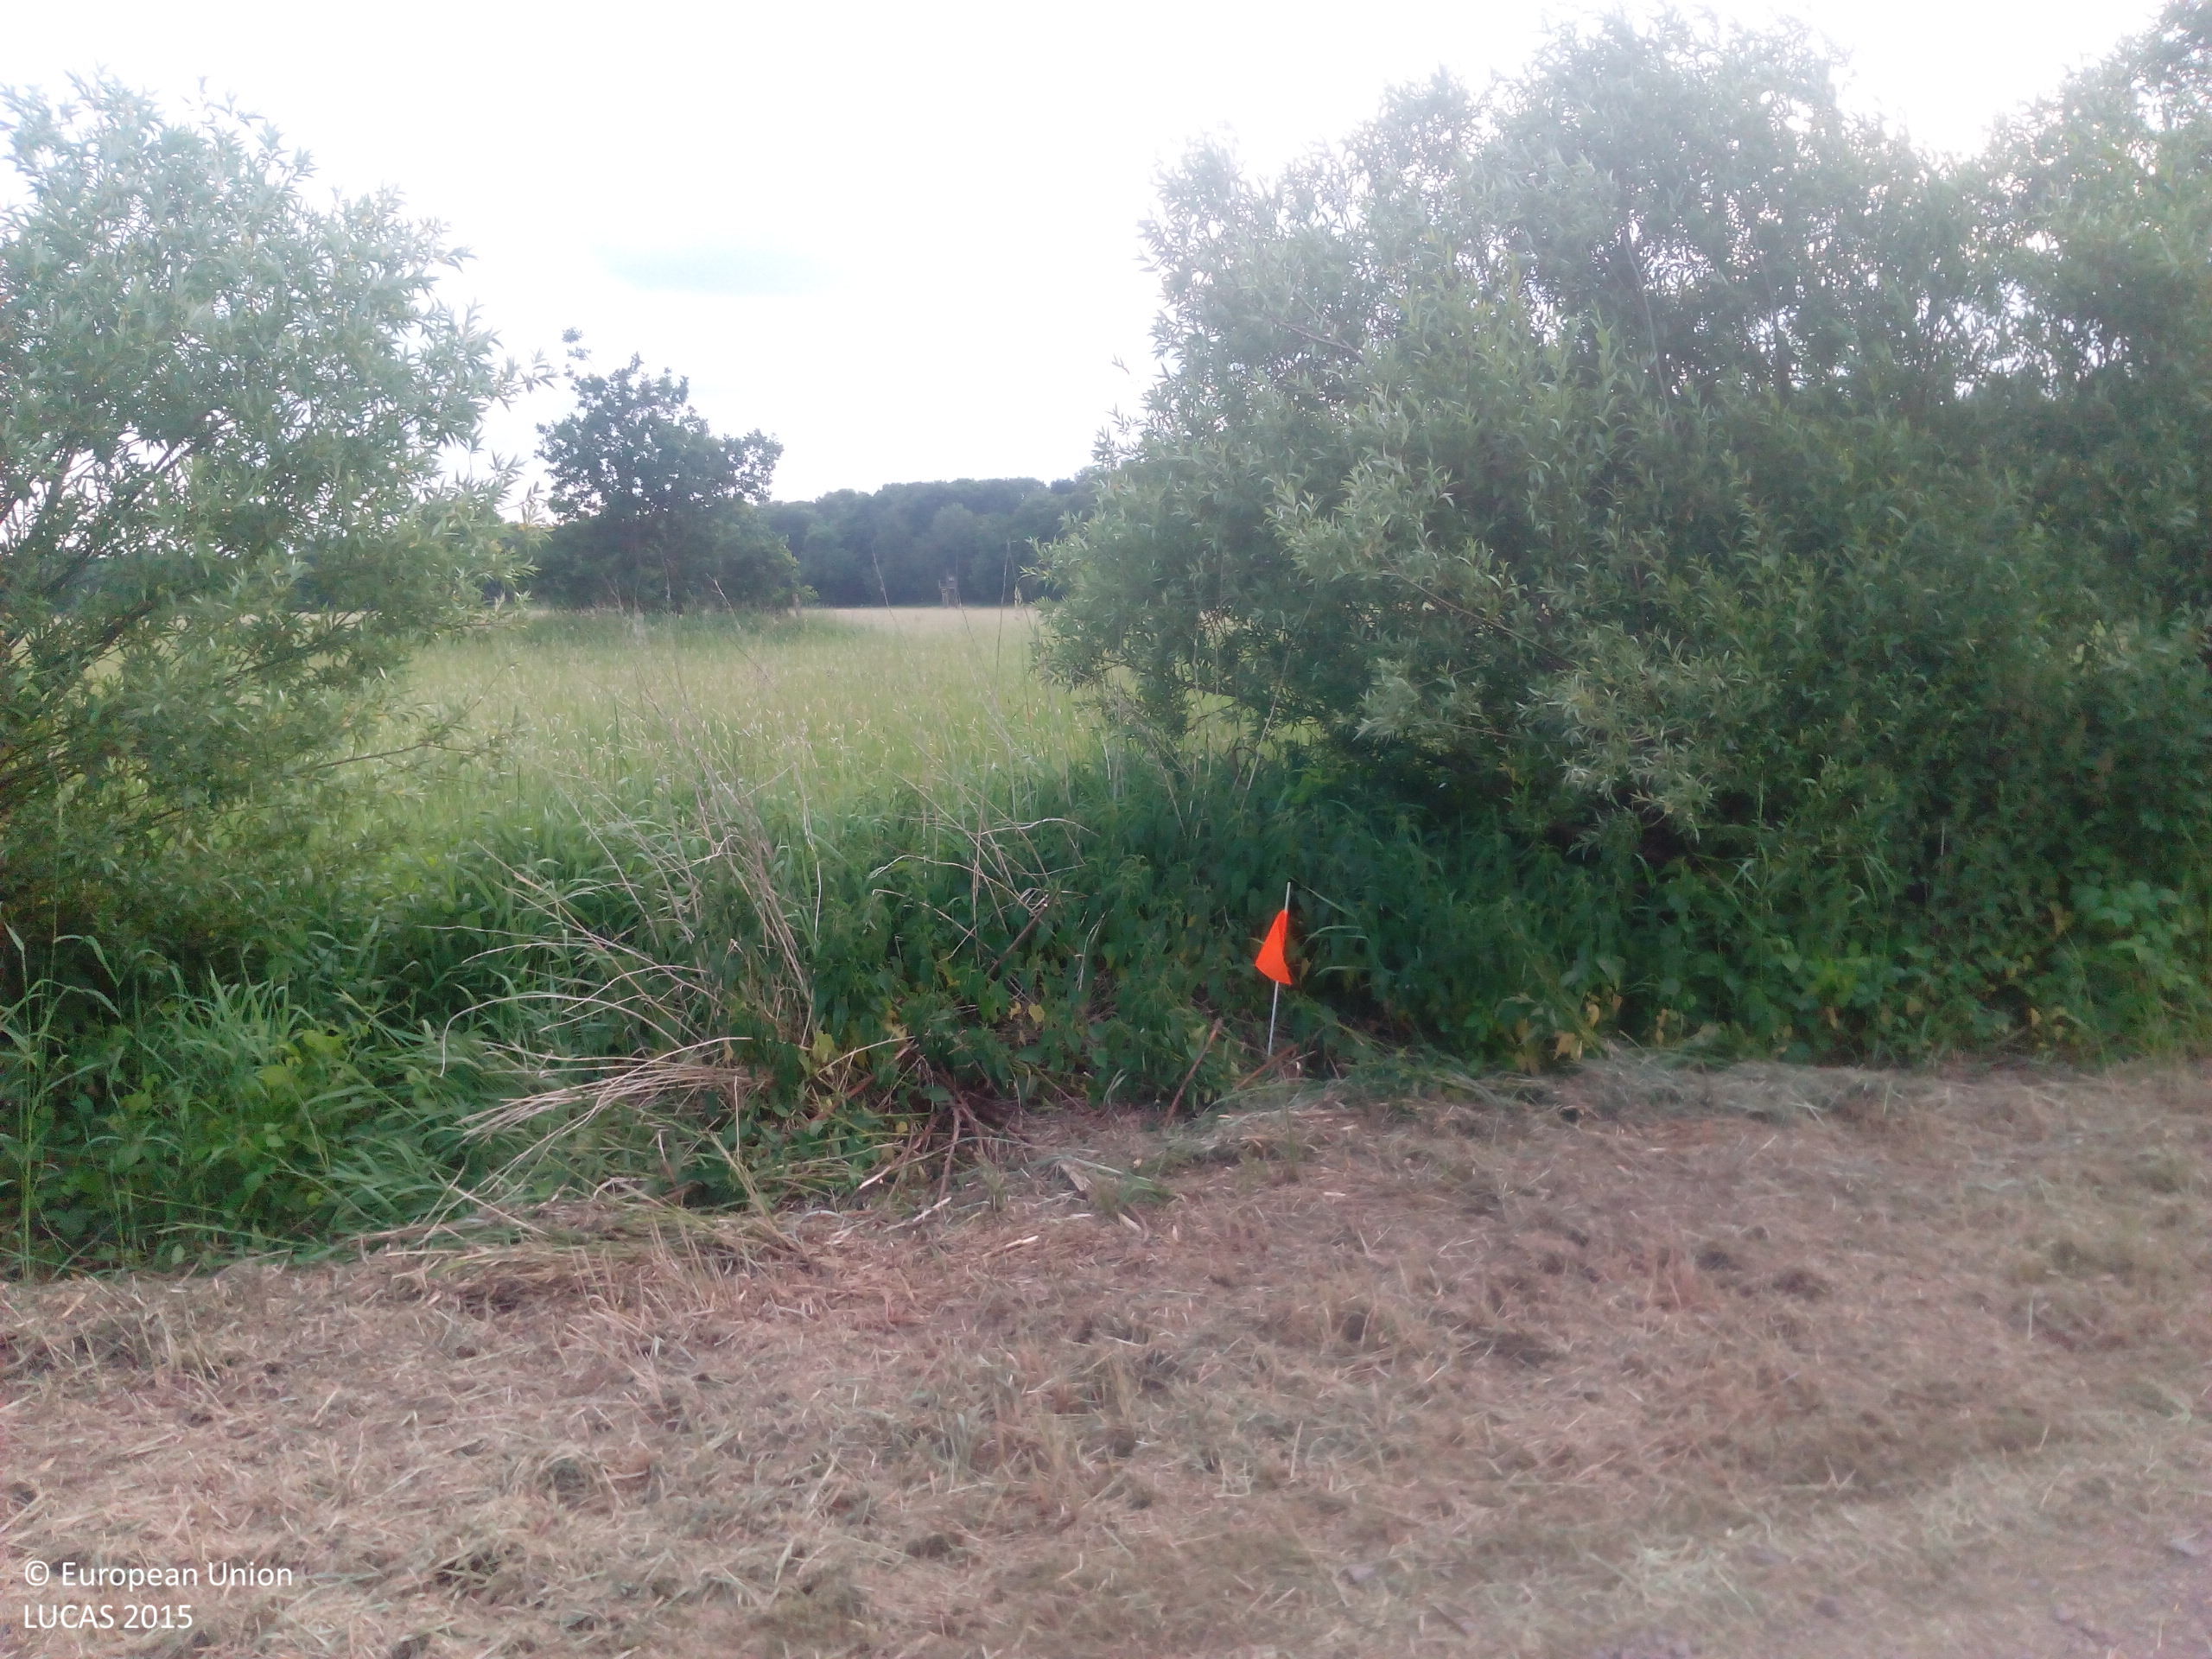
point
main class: Woodland
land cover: Broadleaved woodland
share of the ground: > 75 %
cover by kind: broadleaved forest trees 75 %, herbaceous plants 25 %
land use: Road transport
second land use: Agriculture (excluding fallow land and kitchen gardens)
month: June
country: DE
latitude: 51.8498
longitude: 12.3950
